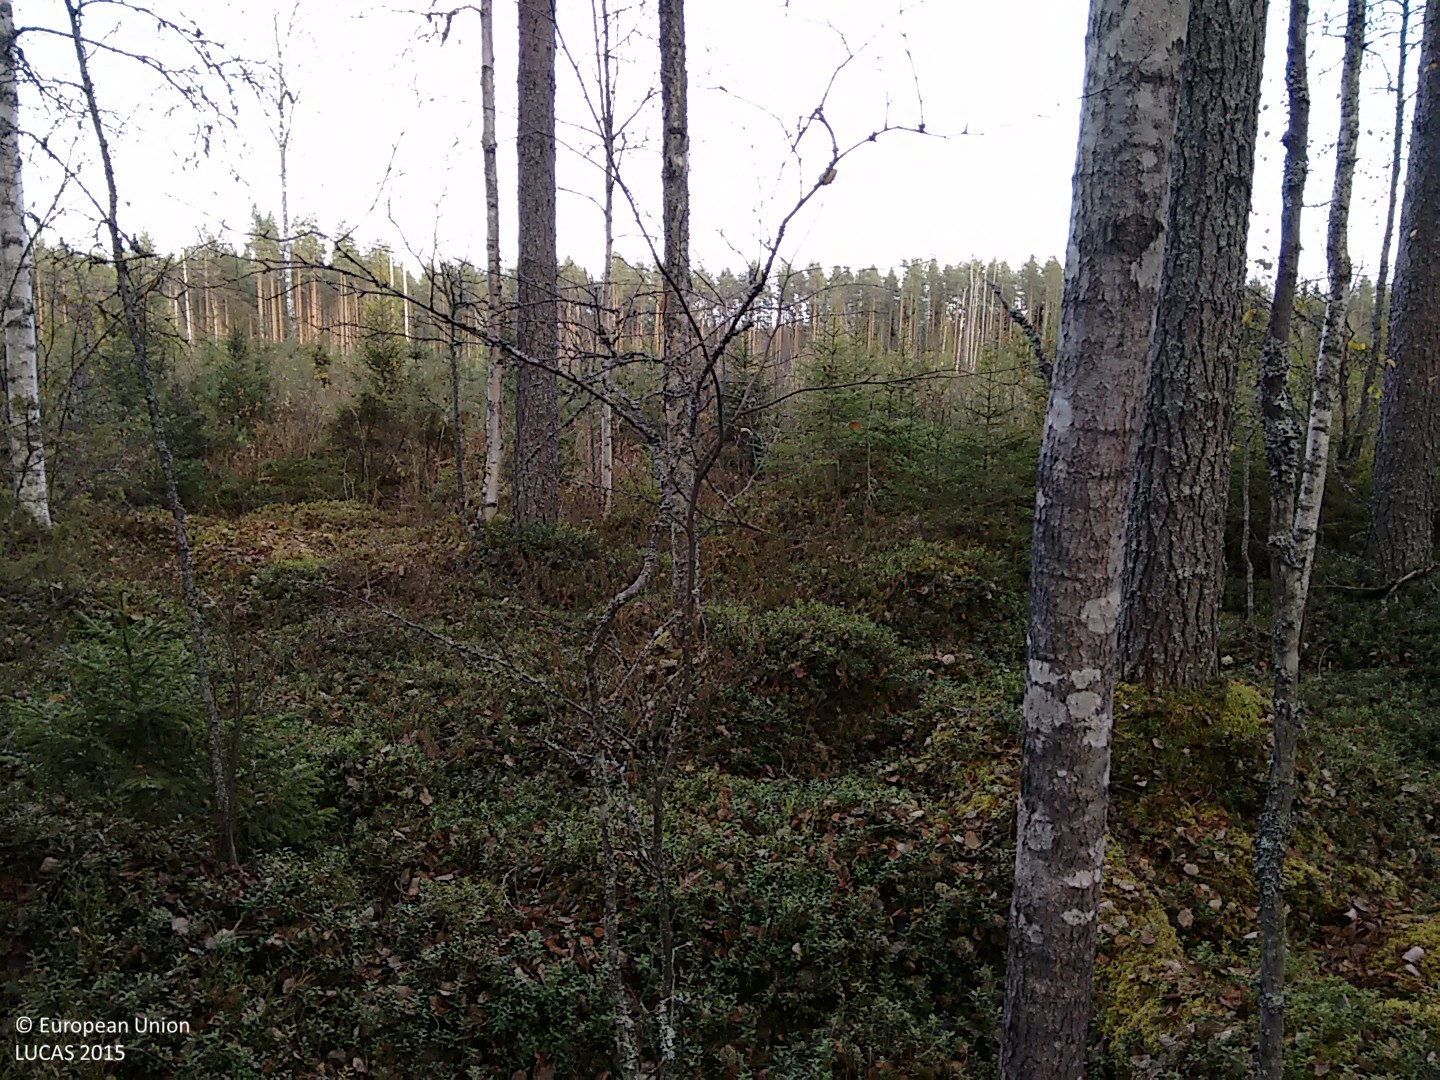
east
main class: Woodland
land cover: Pine dominated mixed woodland
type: boreal forest
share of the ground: > 75 %
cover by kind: broadleaved forest trees 45 %, coniferous forest trees 40 %, shrubs 10 %, herbaceous plants 5 %
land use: Forestry
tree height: > 5 m
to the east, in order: Pine dominated mixed woodland; Ditches and canals; Pine dominated coniferous woodland; Ditches and canals; Pine dominated coniferous woodland; Shrubland with sparse tree cover; Ditches and canals; Shrubland with sparse tree cover; Pine dominated mixed woodland
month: October
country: FI
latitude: 63.9264
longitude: 25.1172
